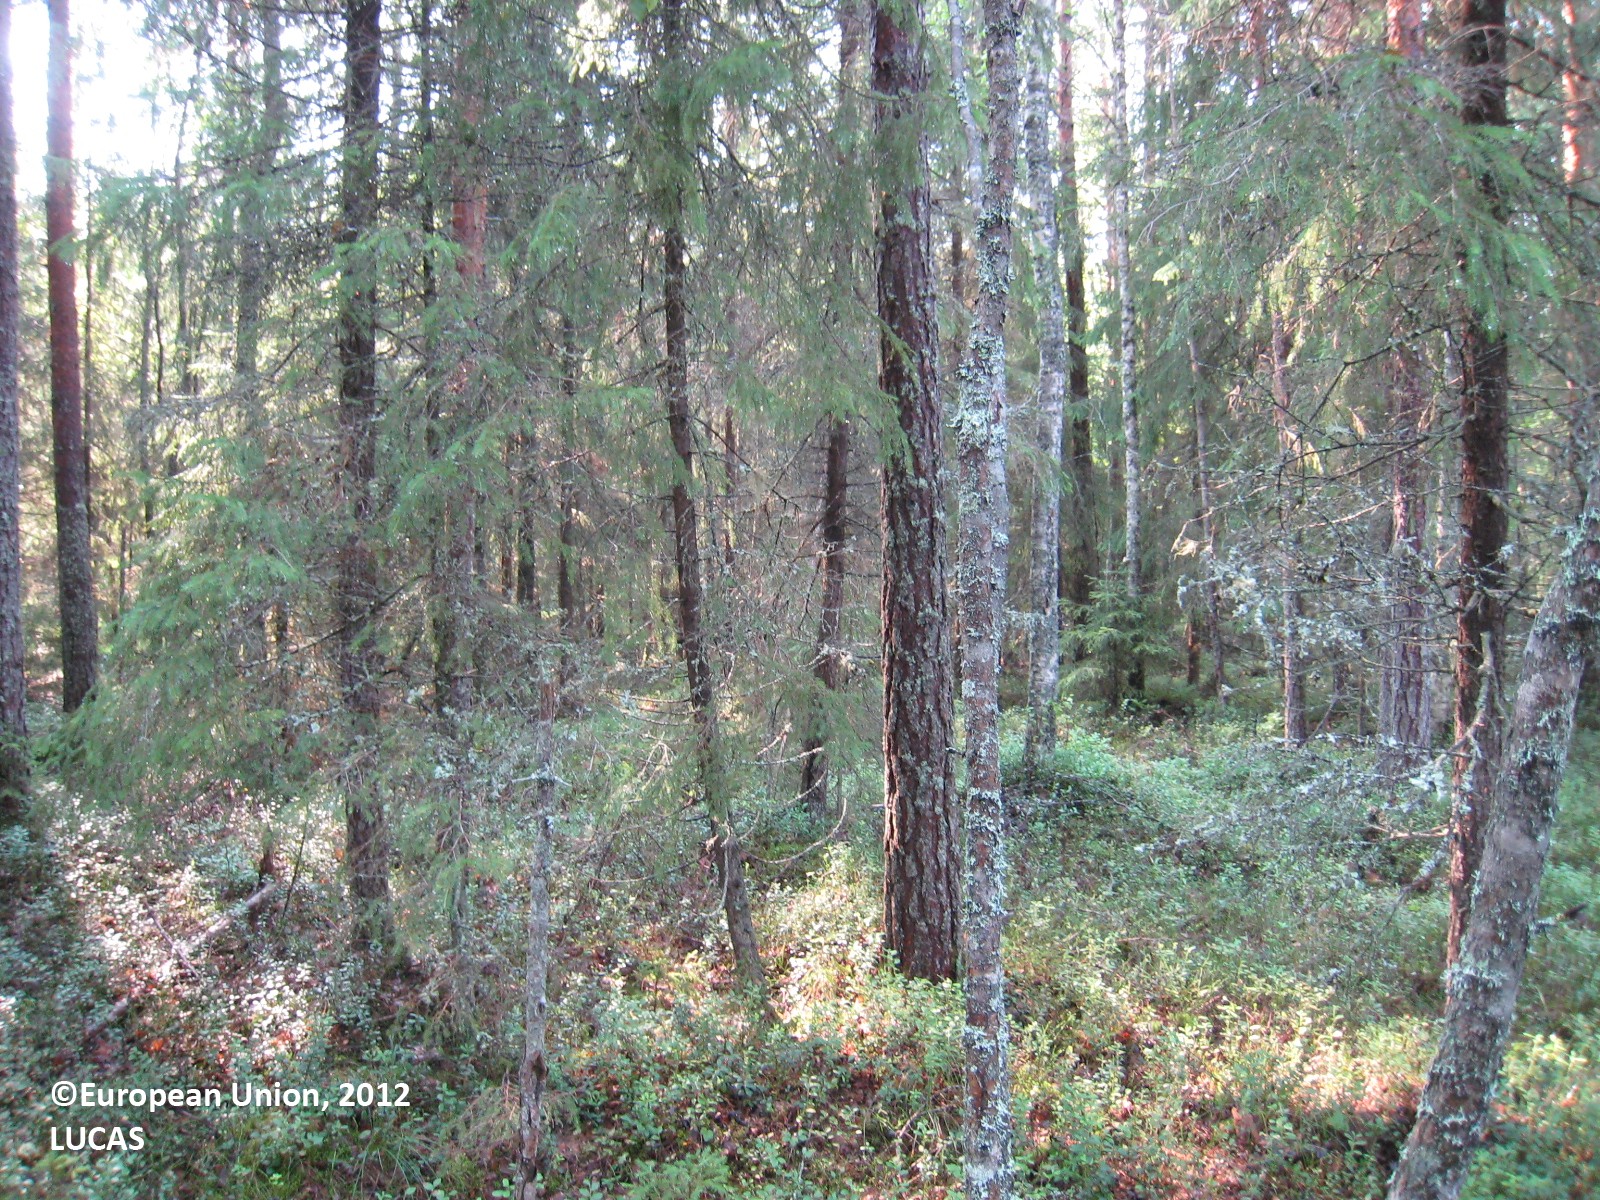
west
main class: Woodland
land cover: Other mixed woodland
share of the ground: > 75 %
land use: Forestry
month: July
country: FI
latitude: 62.4328
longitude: 27.3034
